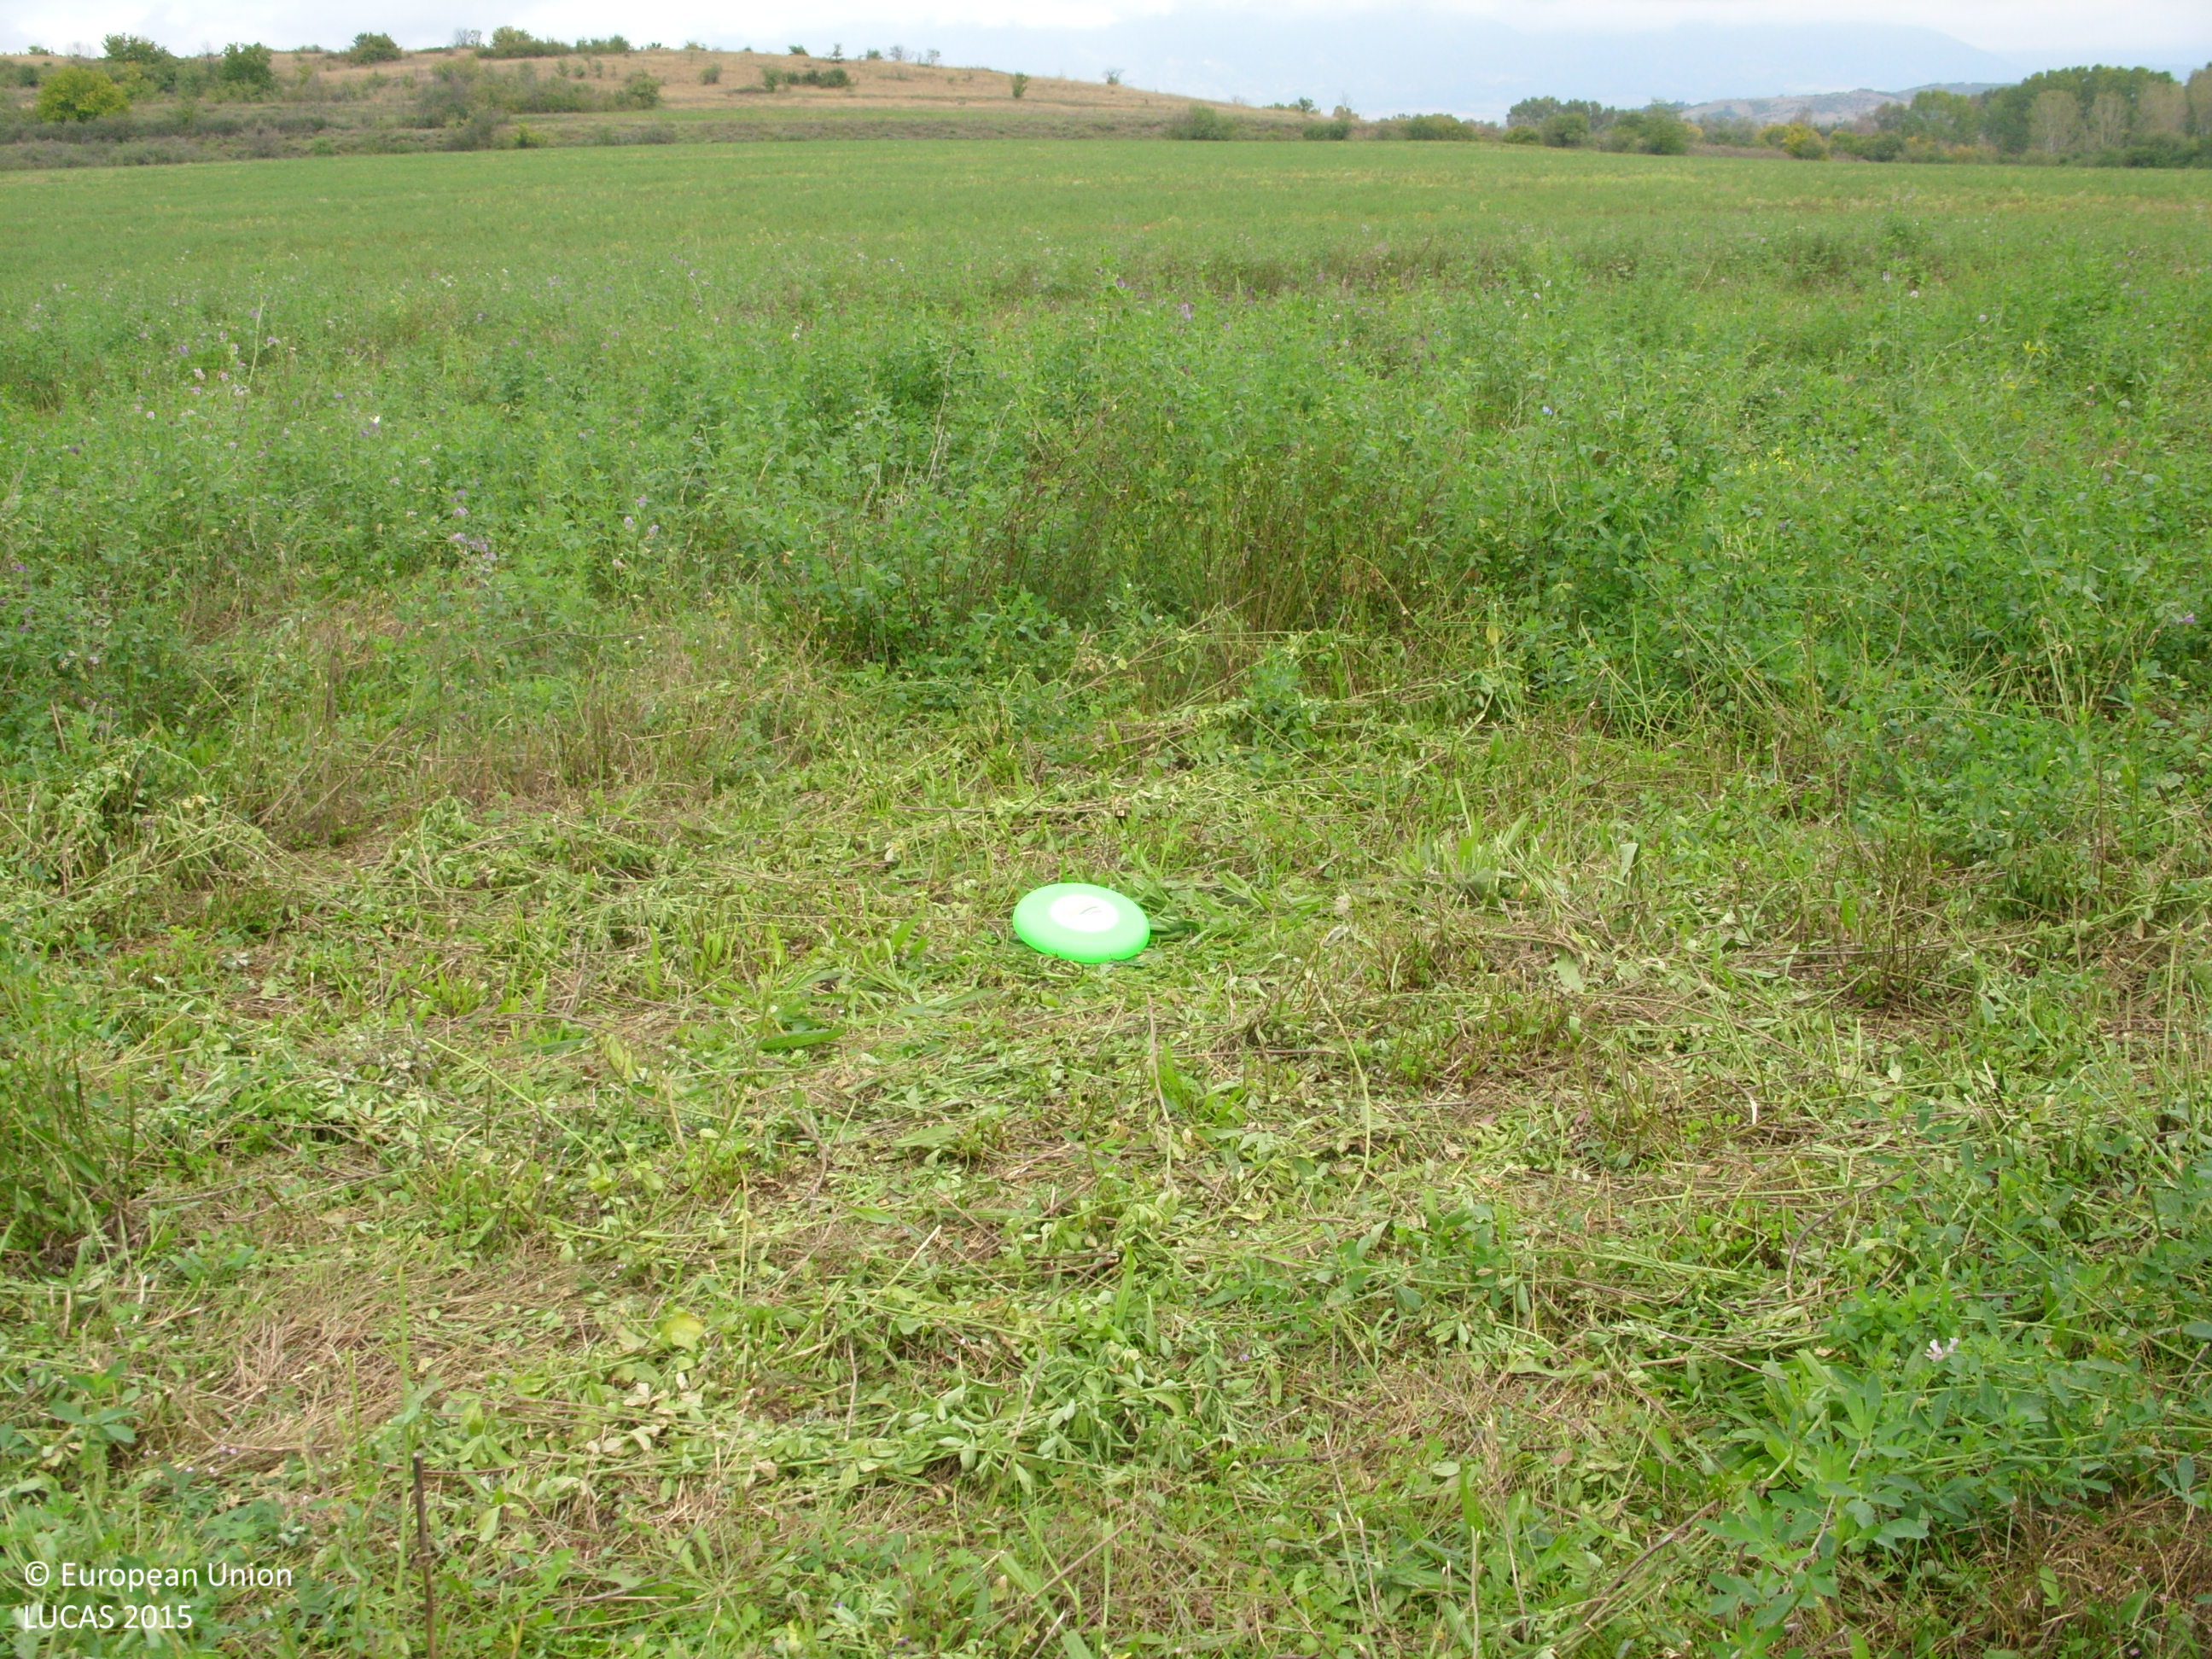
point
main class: Cropland
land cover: Lucerne
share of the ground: > 75 %
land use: Agriculture (excluding fallow land and kitchen gardens)
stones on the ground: < 10 %
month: October
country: BG
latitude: 42.5277
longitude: 24.8242
